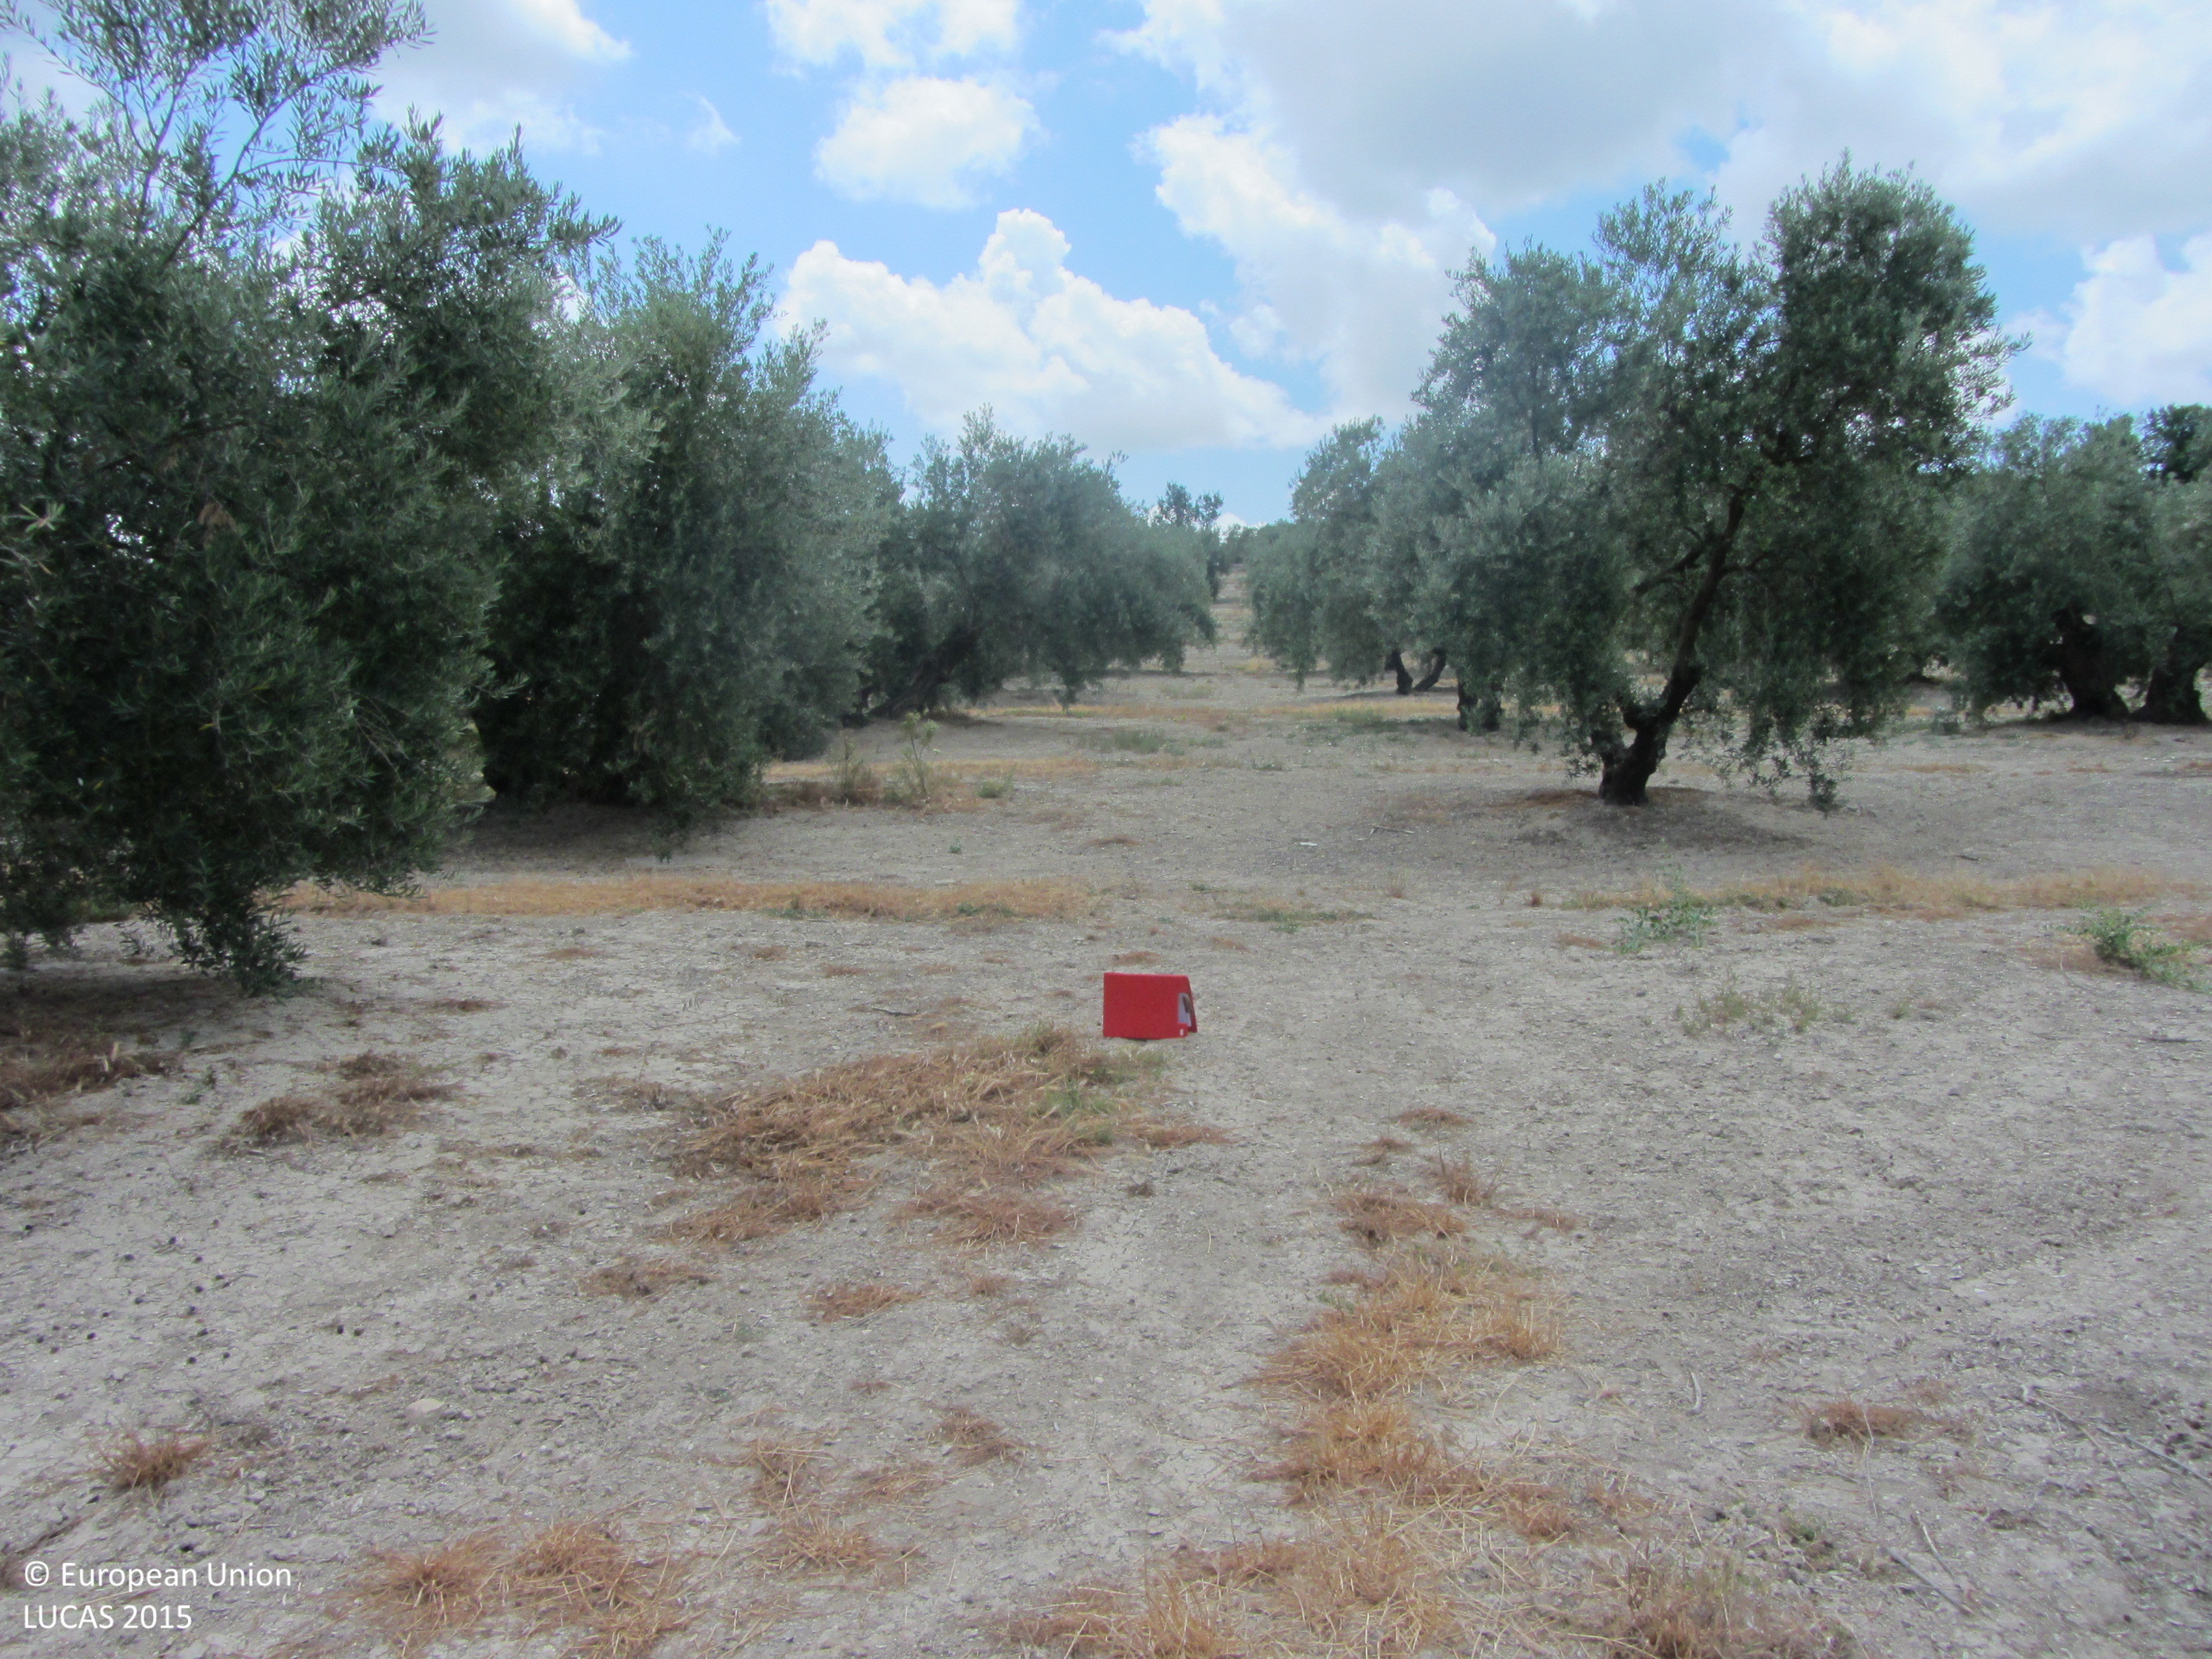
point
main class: Cropland
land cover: Olive groves
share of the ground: 25 - 50 %
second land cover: Other bare soil
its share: > 75 %
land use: Agriculture (excluding fallow land and kitchen gardens)
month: June
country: ES
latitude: 38.1380
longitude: -3.1088
